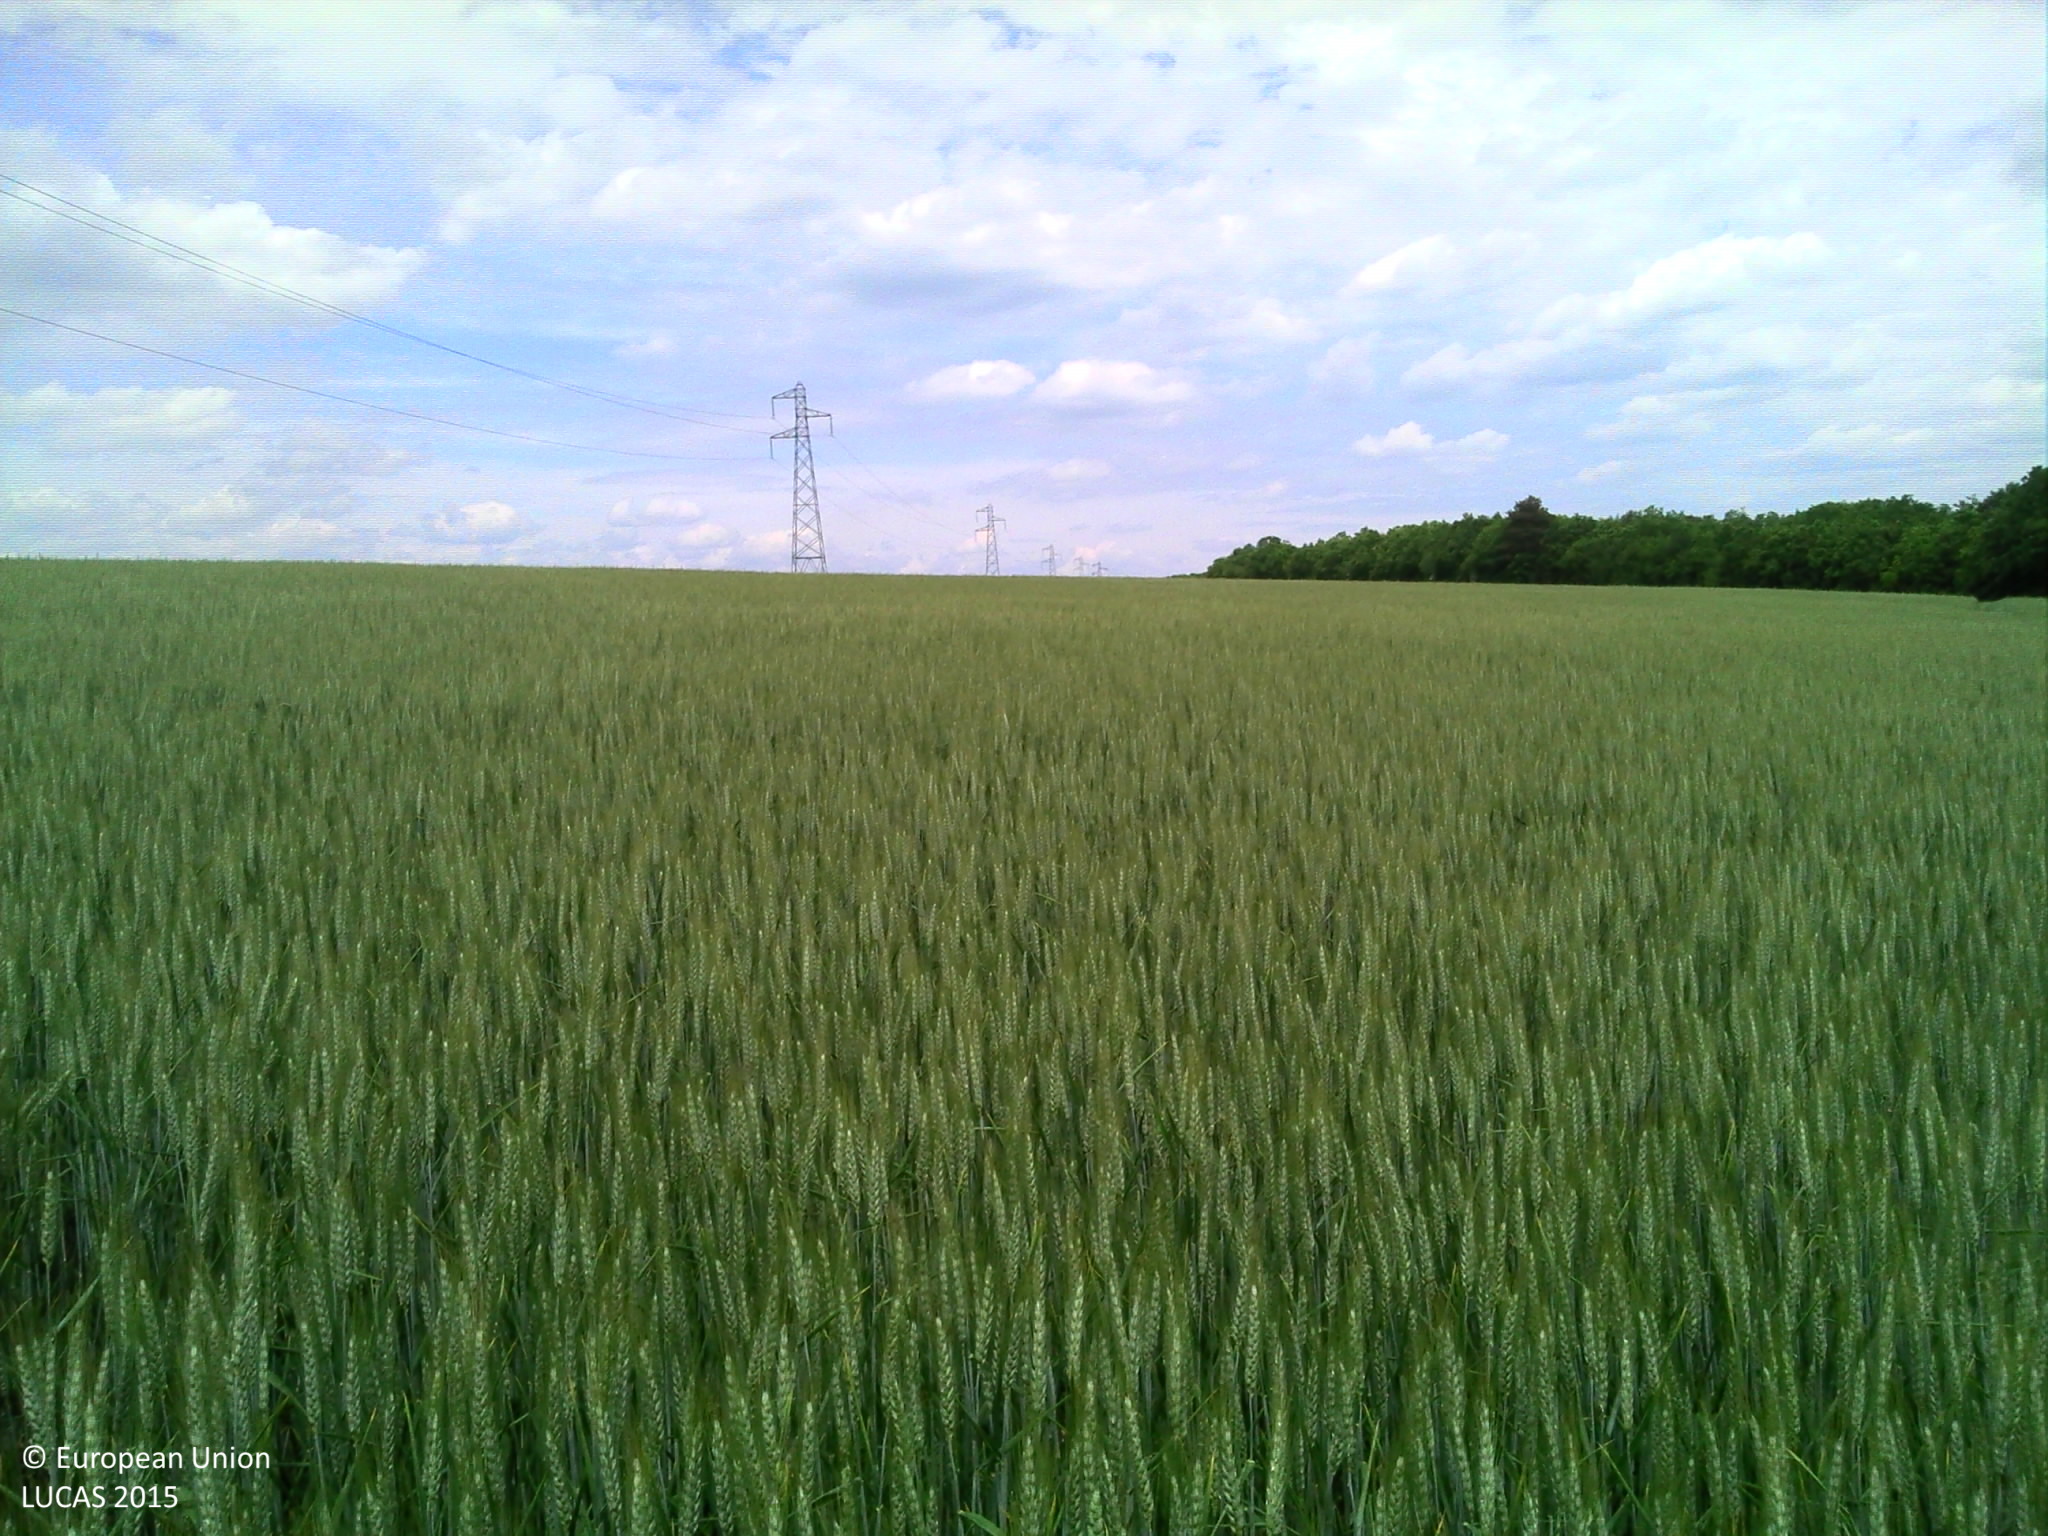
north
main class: Cropland
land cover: Common wheat
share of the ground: > 75 %
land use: Agriculture (excluding fallow land and kitchen gardens)
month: May
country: FR
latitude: 47.7494
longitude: 3.9281
